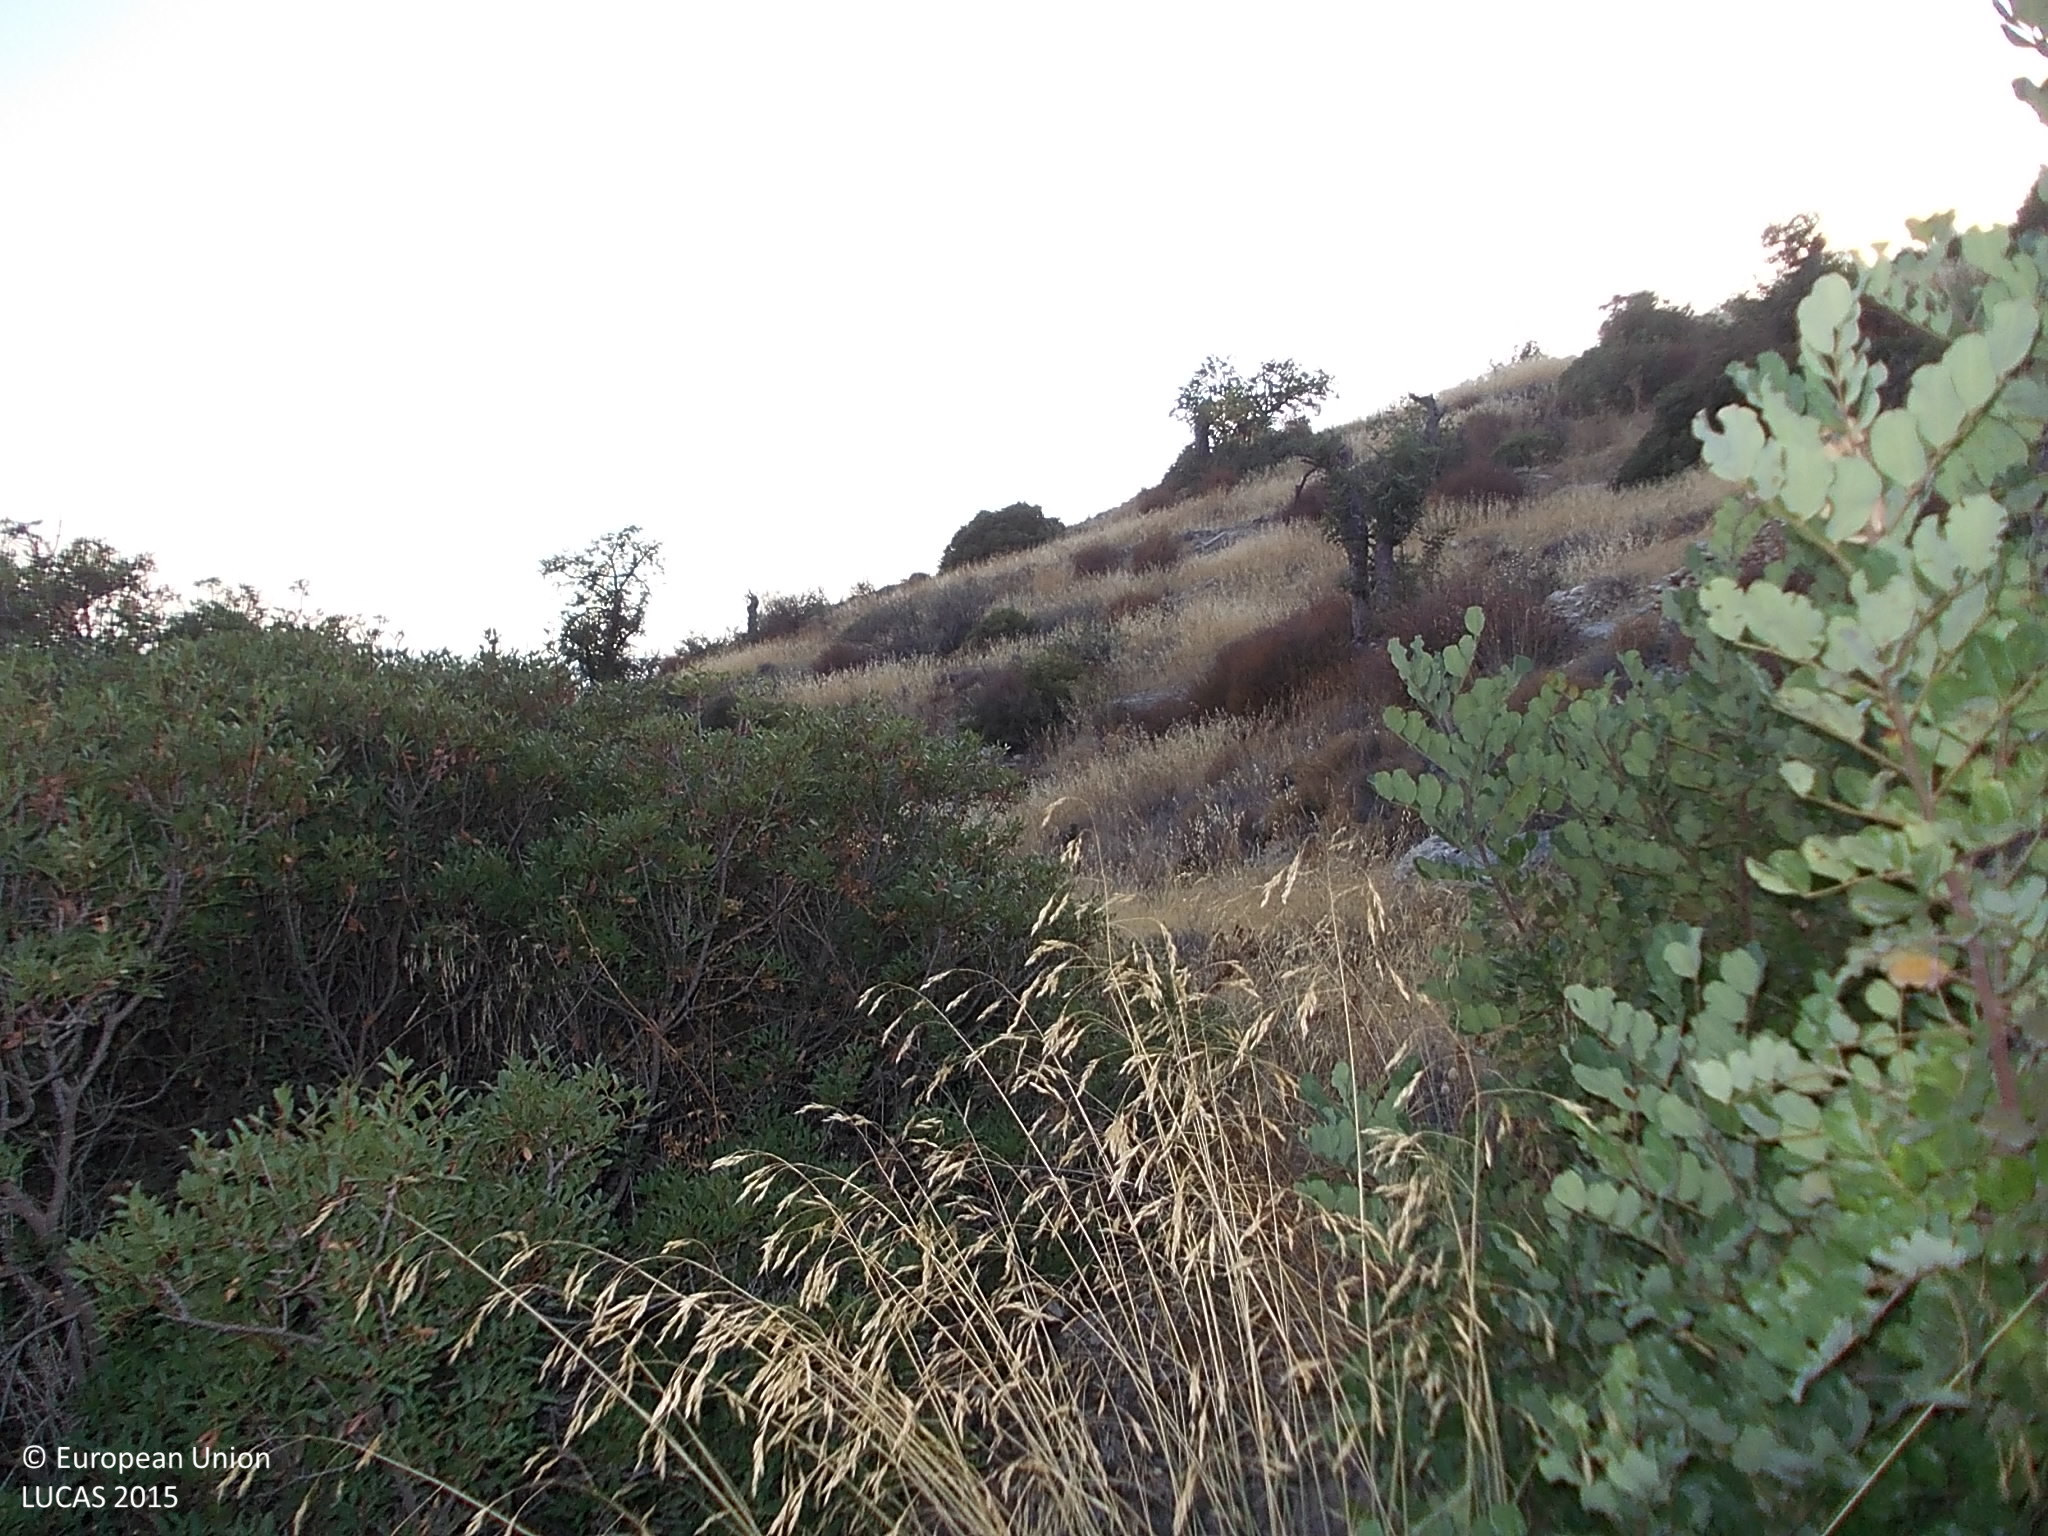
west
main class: Shrubland
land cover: Shrubland with sparse tree cover
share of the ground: > 75 %
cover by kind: shrubs 75 %, herbaceous plants 15 %, broadleaved forest trees 5 %, consolidated bare surface 5 %
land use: Semi-natural and natural areas not in use
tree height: < 5 m
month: August
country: CY
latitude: 34.7716
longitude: 33.0140
